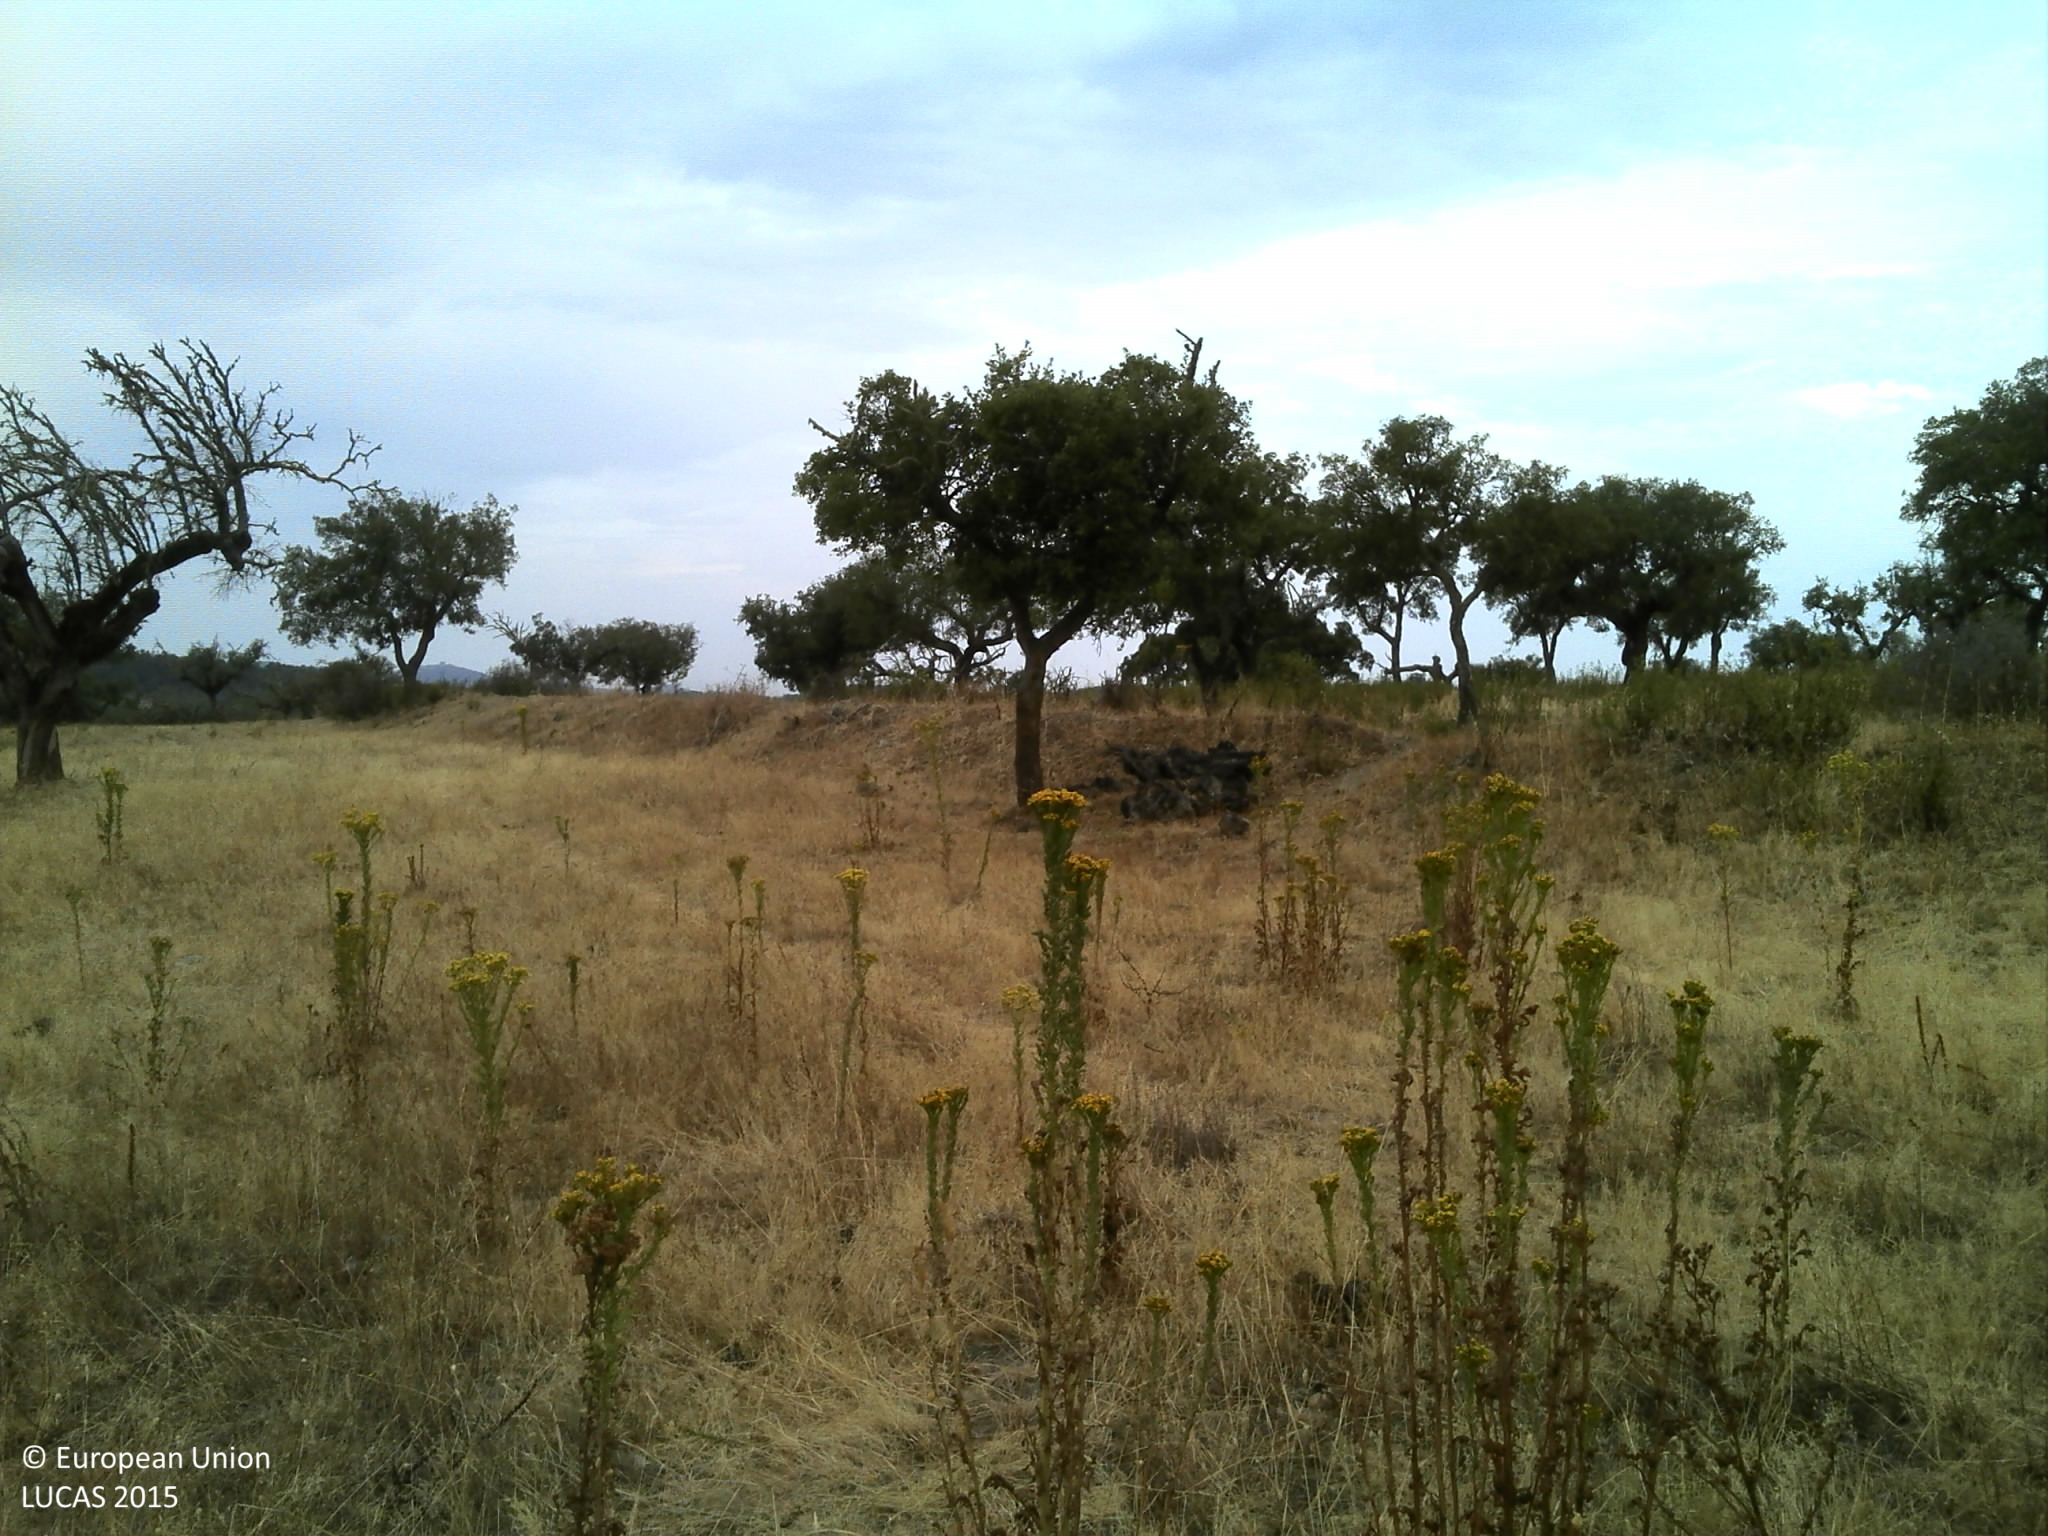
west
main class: Grassland
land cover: Grassland without tree/shrub cover
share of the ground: 25 - 50 %
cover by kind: unconsolidated bare surface 75 %, herbaceous plants 25 %
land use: Agriculture (excluding fallow land and kitchen gardens)
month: July
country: PT
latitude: 38.7967
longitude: -7.5712
